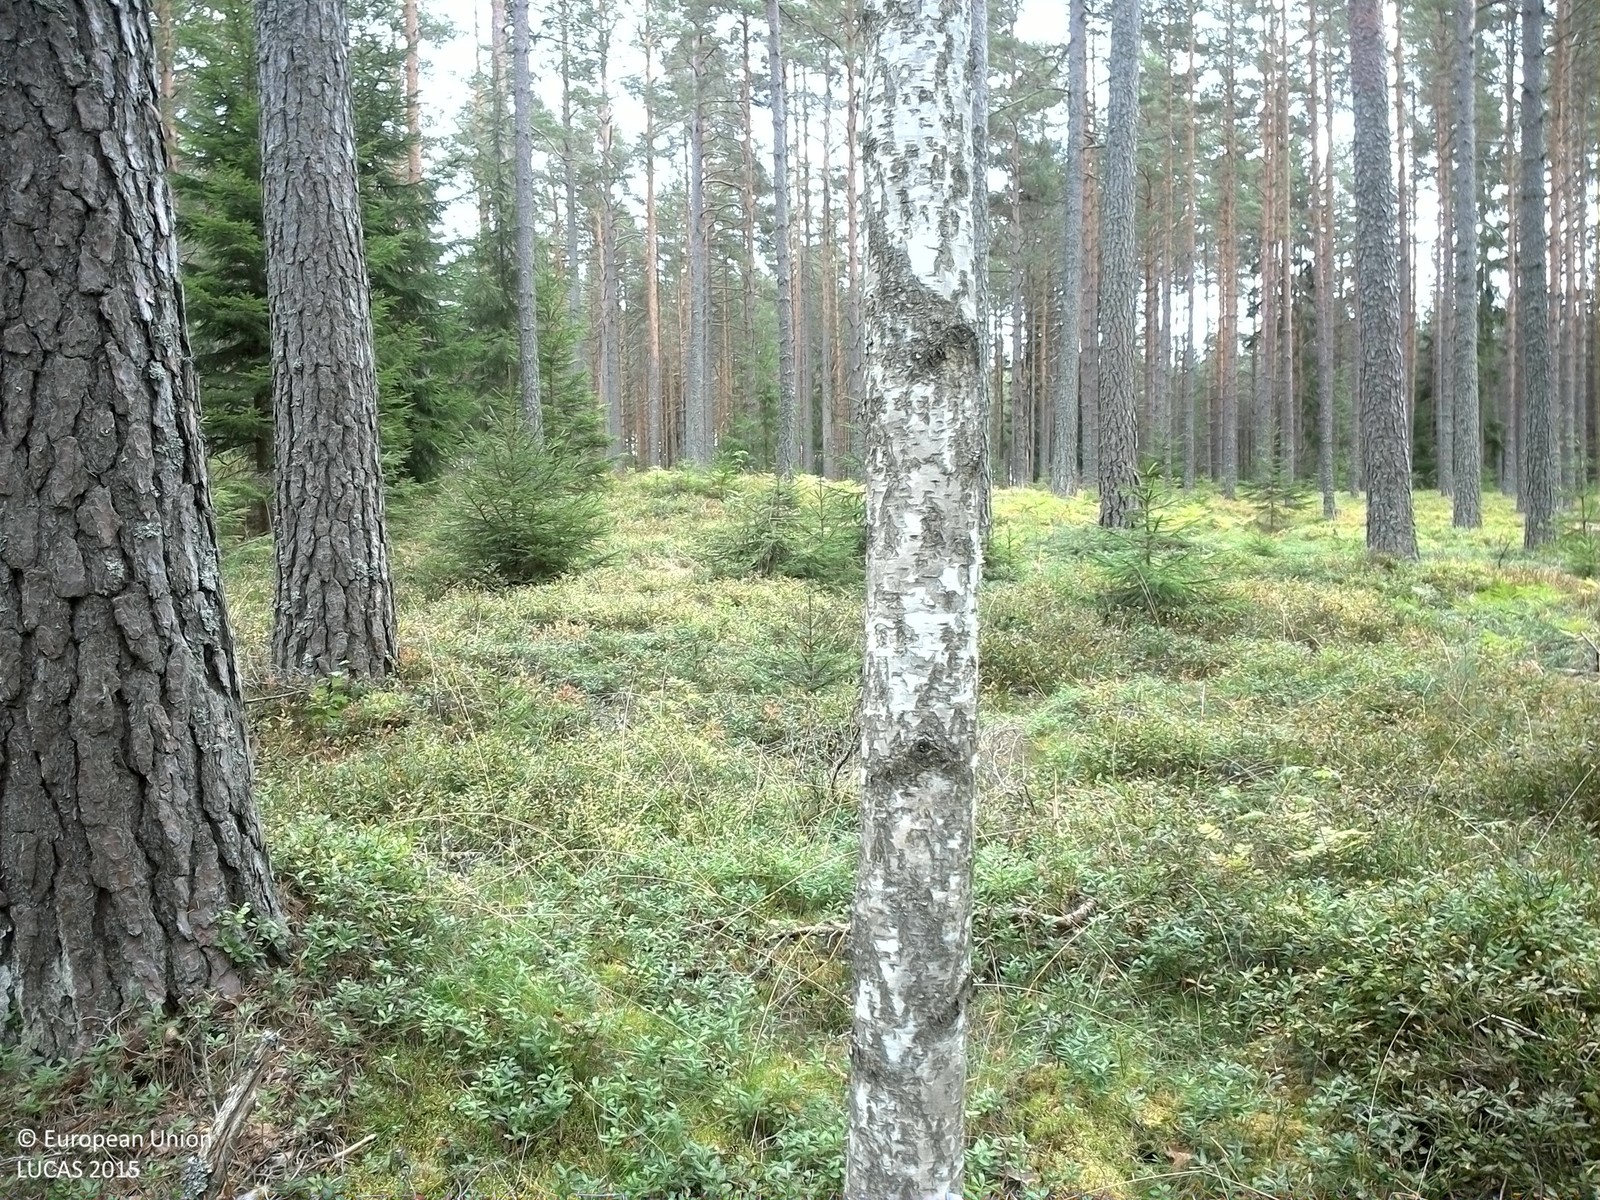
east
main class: Woodland
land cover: Pine dominated coniferous woodland
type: boreal forest
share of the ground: 50 - 75 %
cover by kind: coniferous forest trees 70 %, shrubs 20 %, broadleaved forest trees 5 %, lichens and mosses 5 %
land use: Forestry
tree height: > 5 m
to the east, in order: Pine dominated coniferous woodland; Tracks; Pine dominated coniferous woodland; Tracks; Pine dominated coniferous woodland
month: September
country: SE
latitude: 59.7418
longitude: 13.4608
